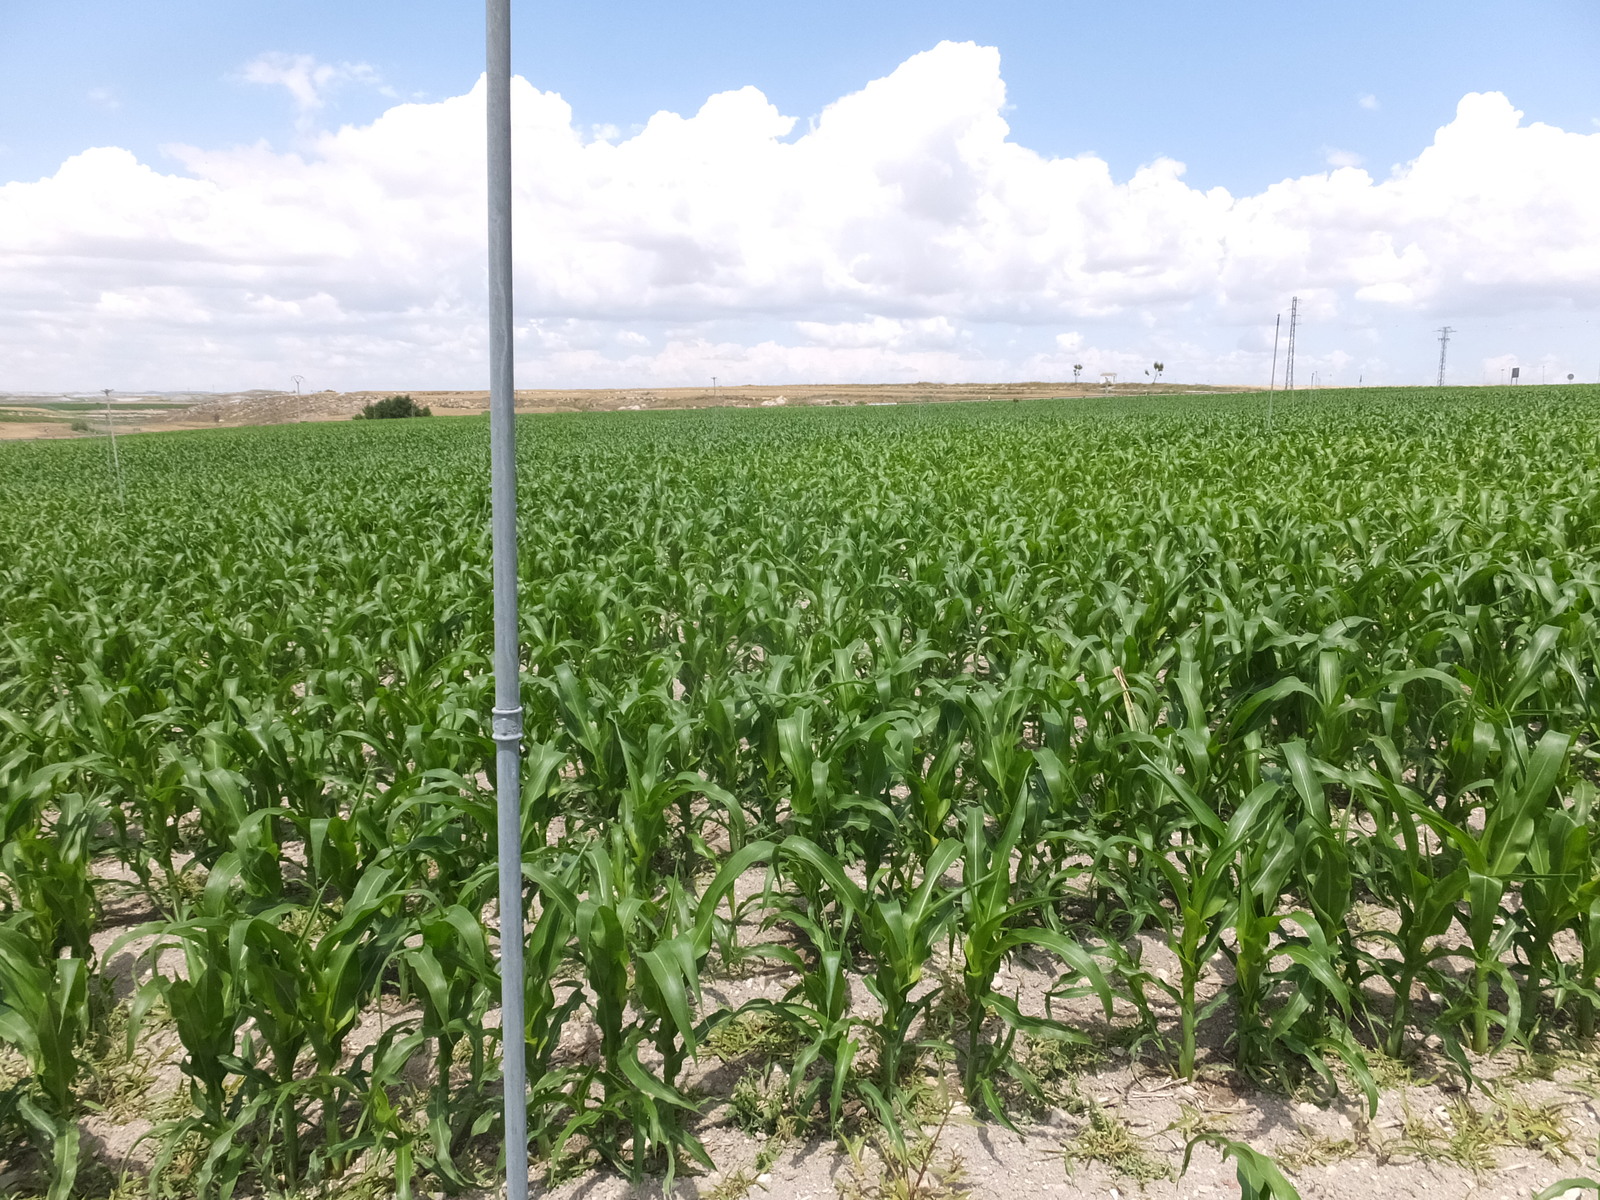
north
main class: Cropland
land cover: Maize
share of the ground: 50 - 75 %
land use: Agriculture (excluding fallow land and kitchen gardens)
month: June
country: ES
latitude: 41.4917
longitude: -0.1126
